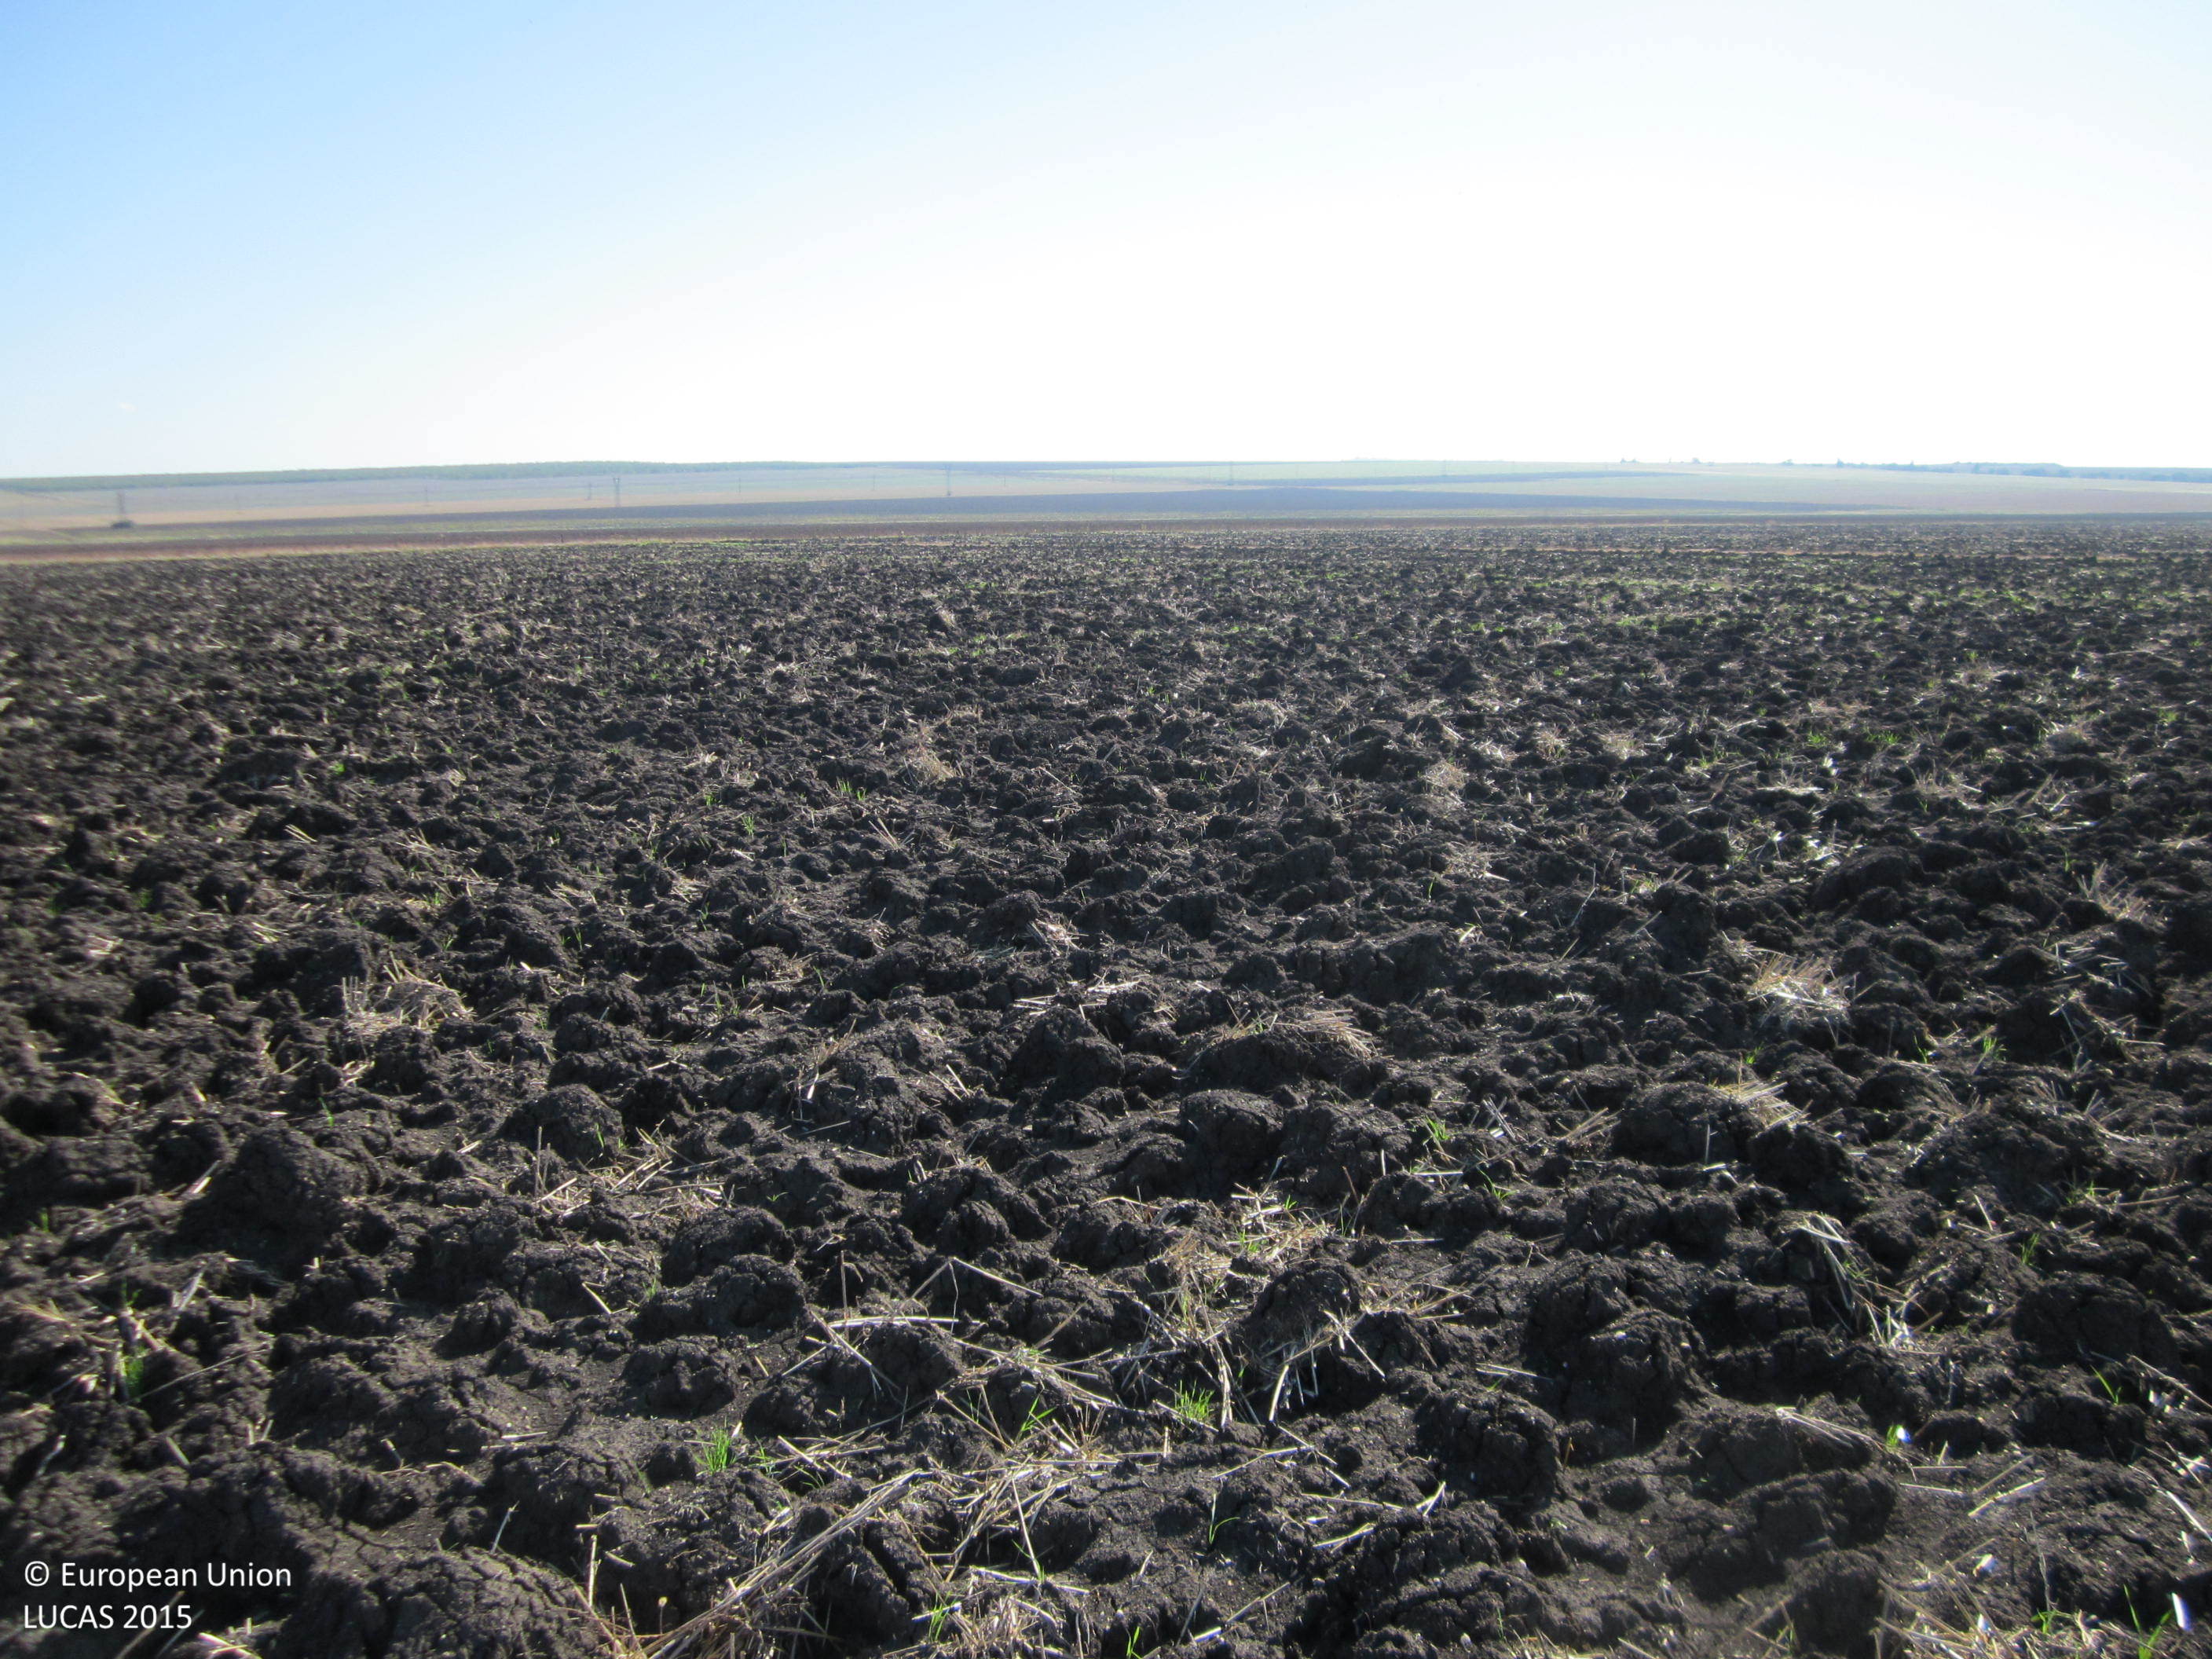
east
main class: Cropland
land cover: Common wheat
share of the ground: < 10 %
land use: Agriculture (excluding fallow land and kitchen gardens)
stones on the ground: < 10 %
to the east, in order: Common wheat; Grass margins; Tracks; Grass margins; Common wheat
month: September
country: BG
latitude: 42.5621
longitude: 27.3501
